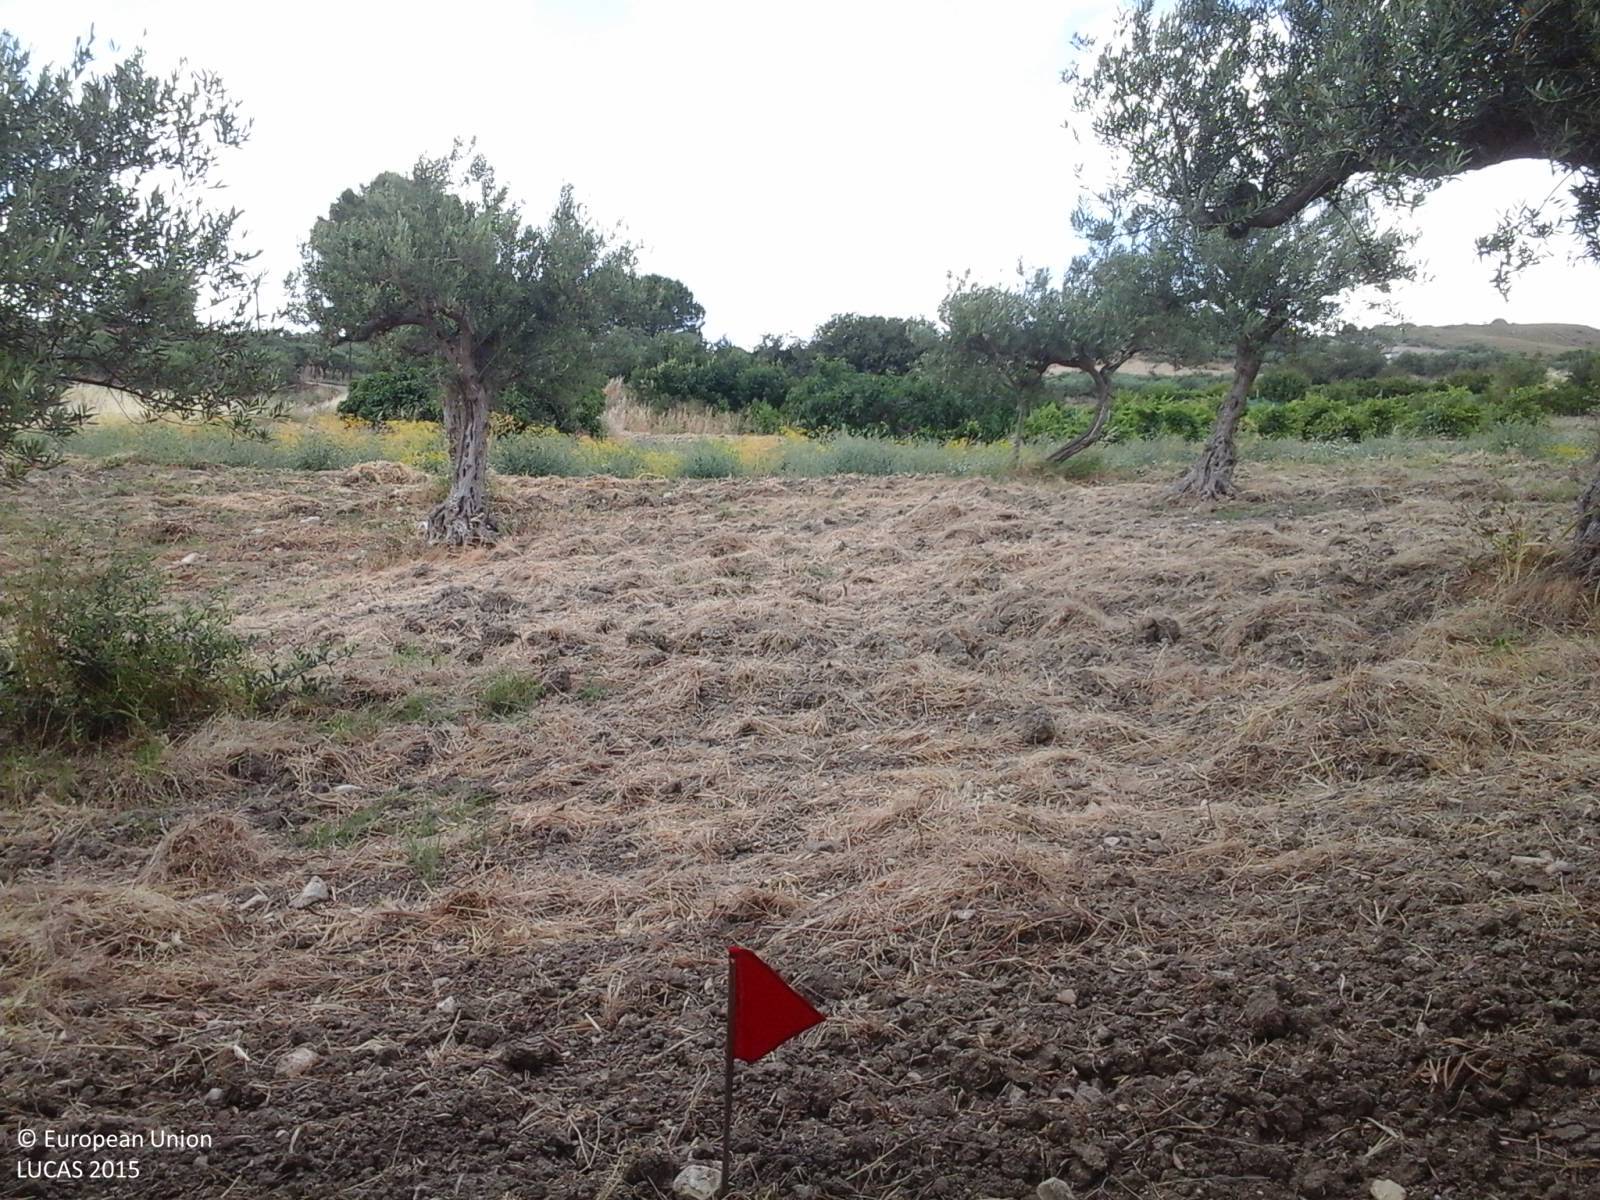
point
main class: Cropland
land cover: Olive groves
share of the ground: 25 - 50 %
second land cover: Other bare soil
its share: > 75 %
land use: Agriculture (excluding fallow land and kitchen gardens)
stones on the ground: < 10 %
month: June
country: IT
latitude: 38.0191
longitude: 12.6577
